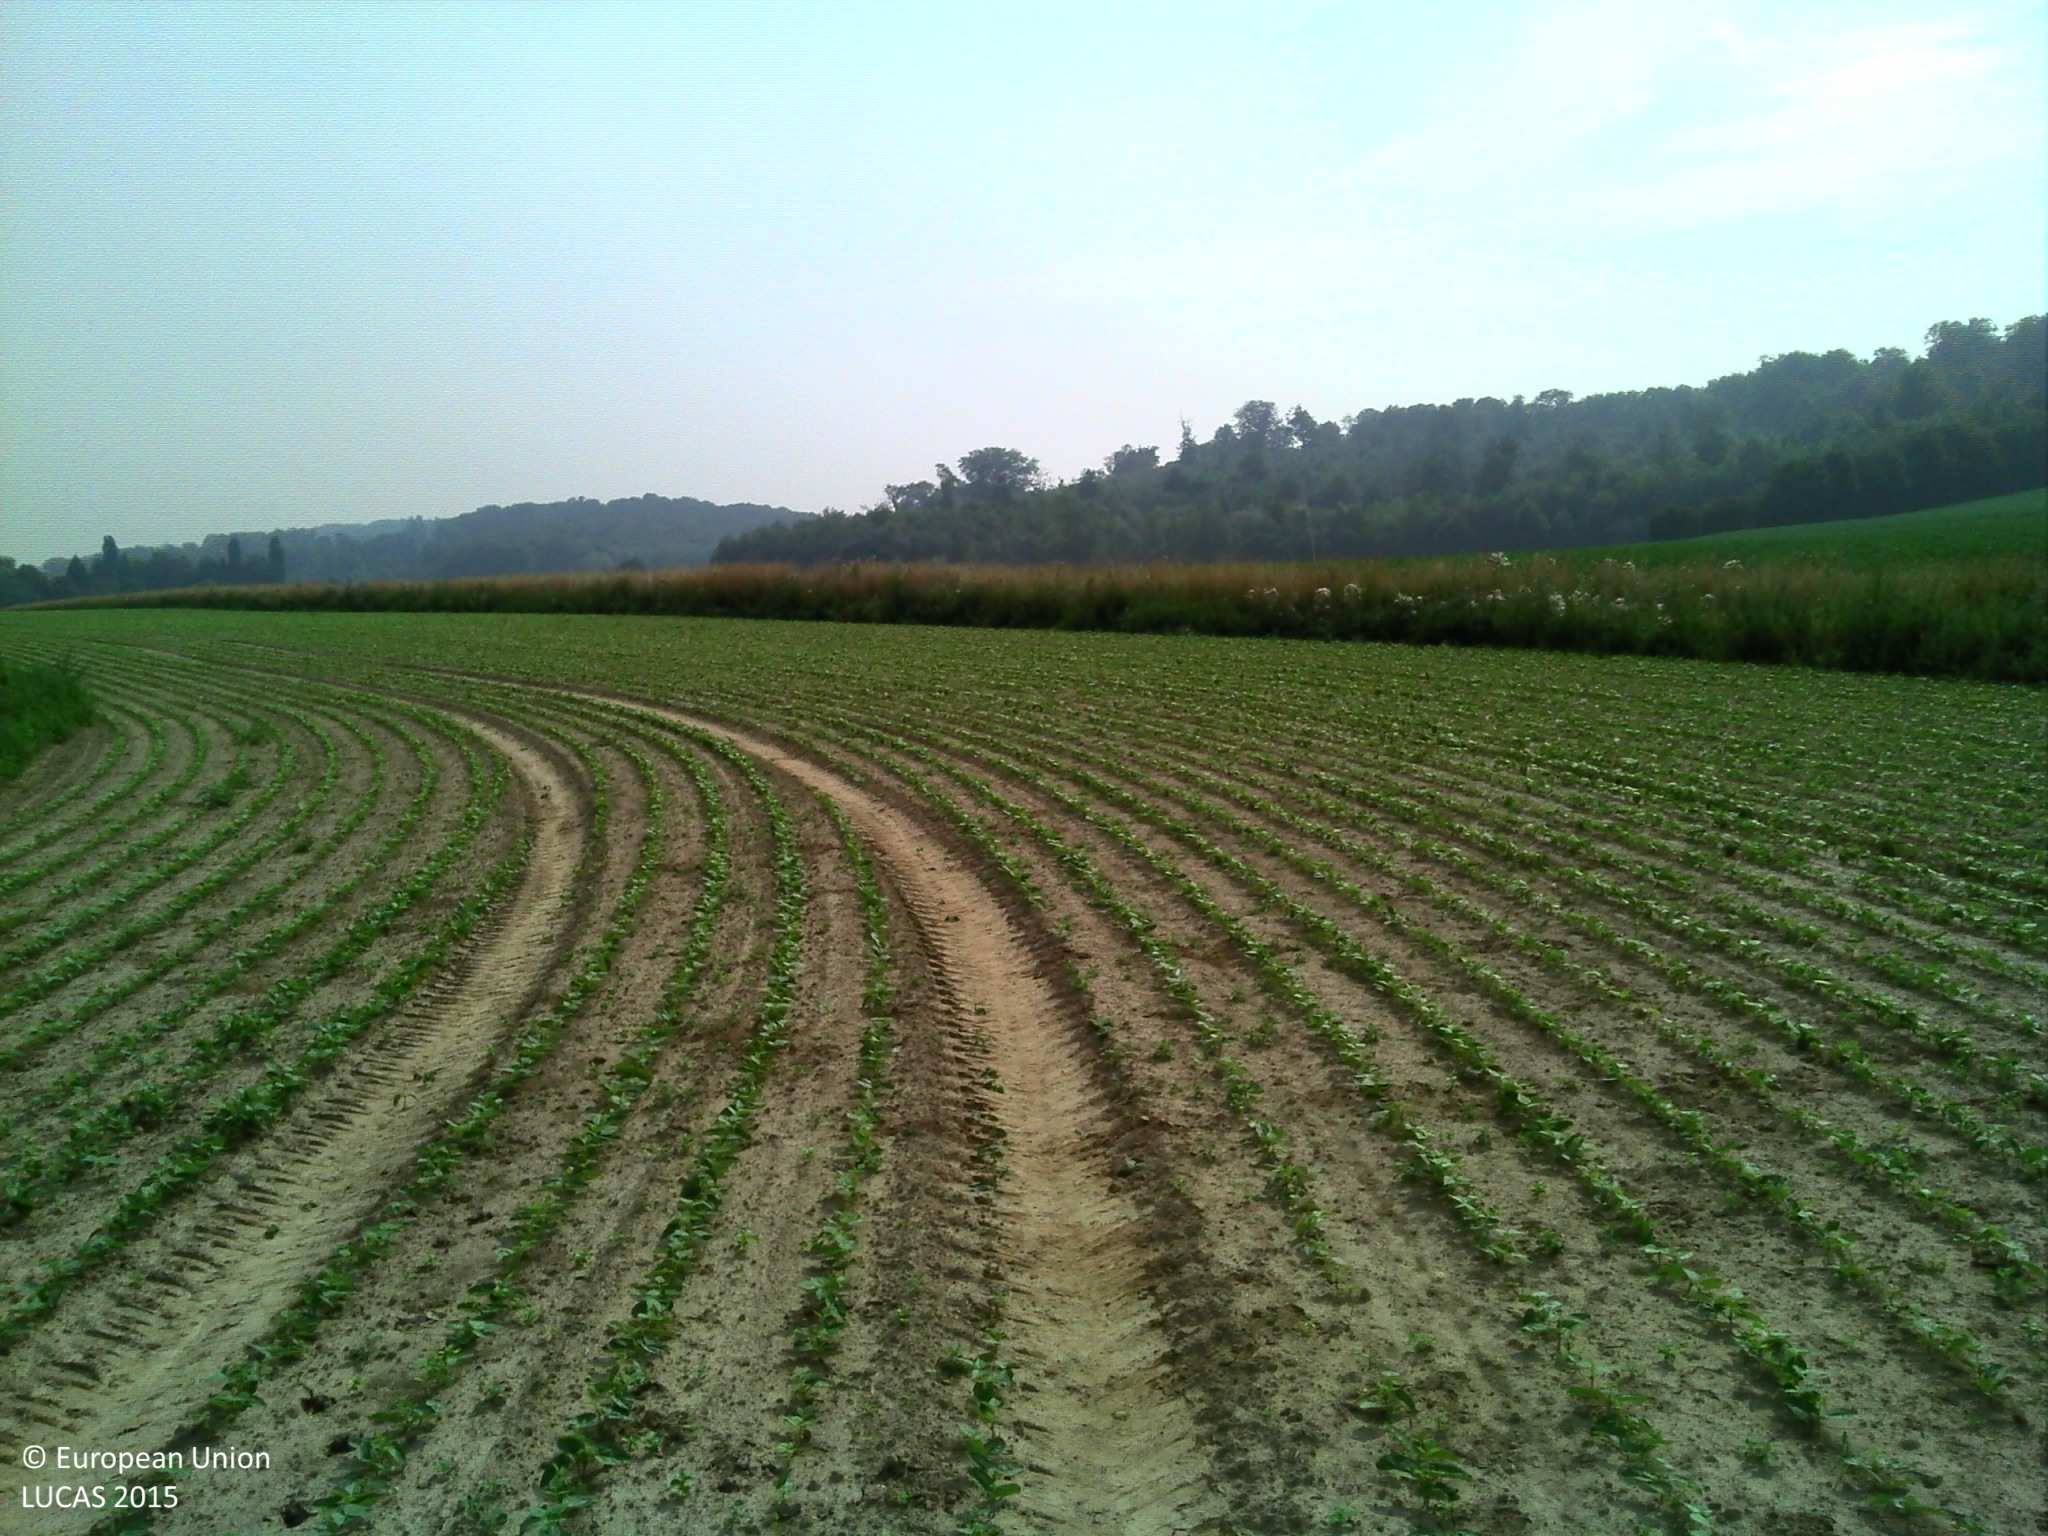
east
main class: Cropland
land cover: Other fresh vegetables
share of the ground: < 10 %
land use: Agriculture (excluding fallow land and kitchen gardens)
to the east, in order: Other fresh vegetables; Grass margins; Temporary grasslands; Other fresh vegetables
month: August
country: BE
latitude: 50.6319
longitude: 3.5314
